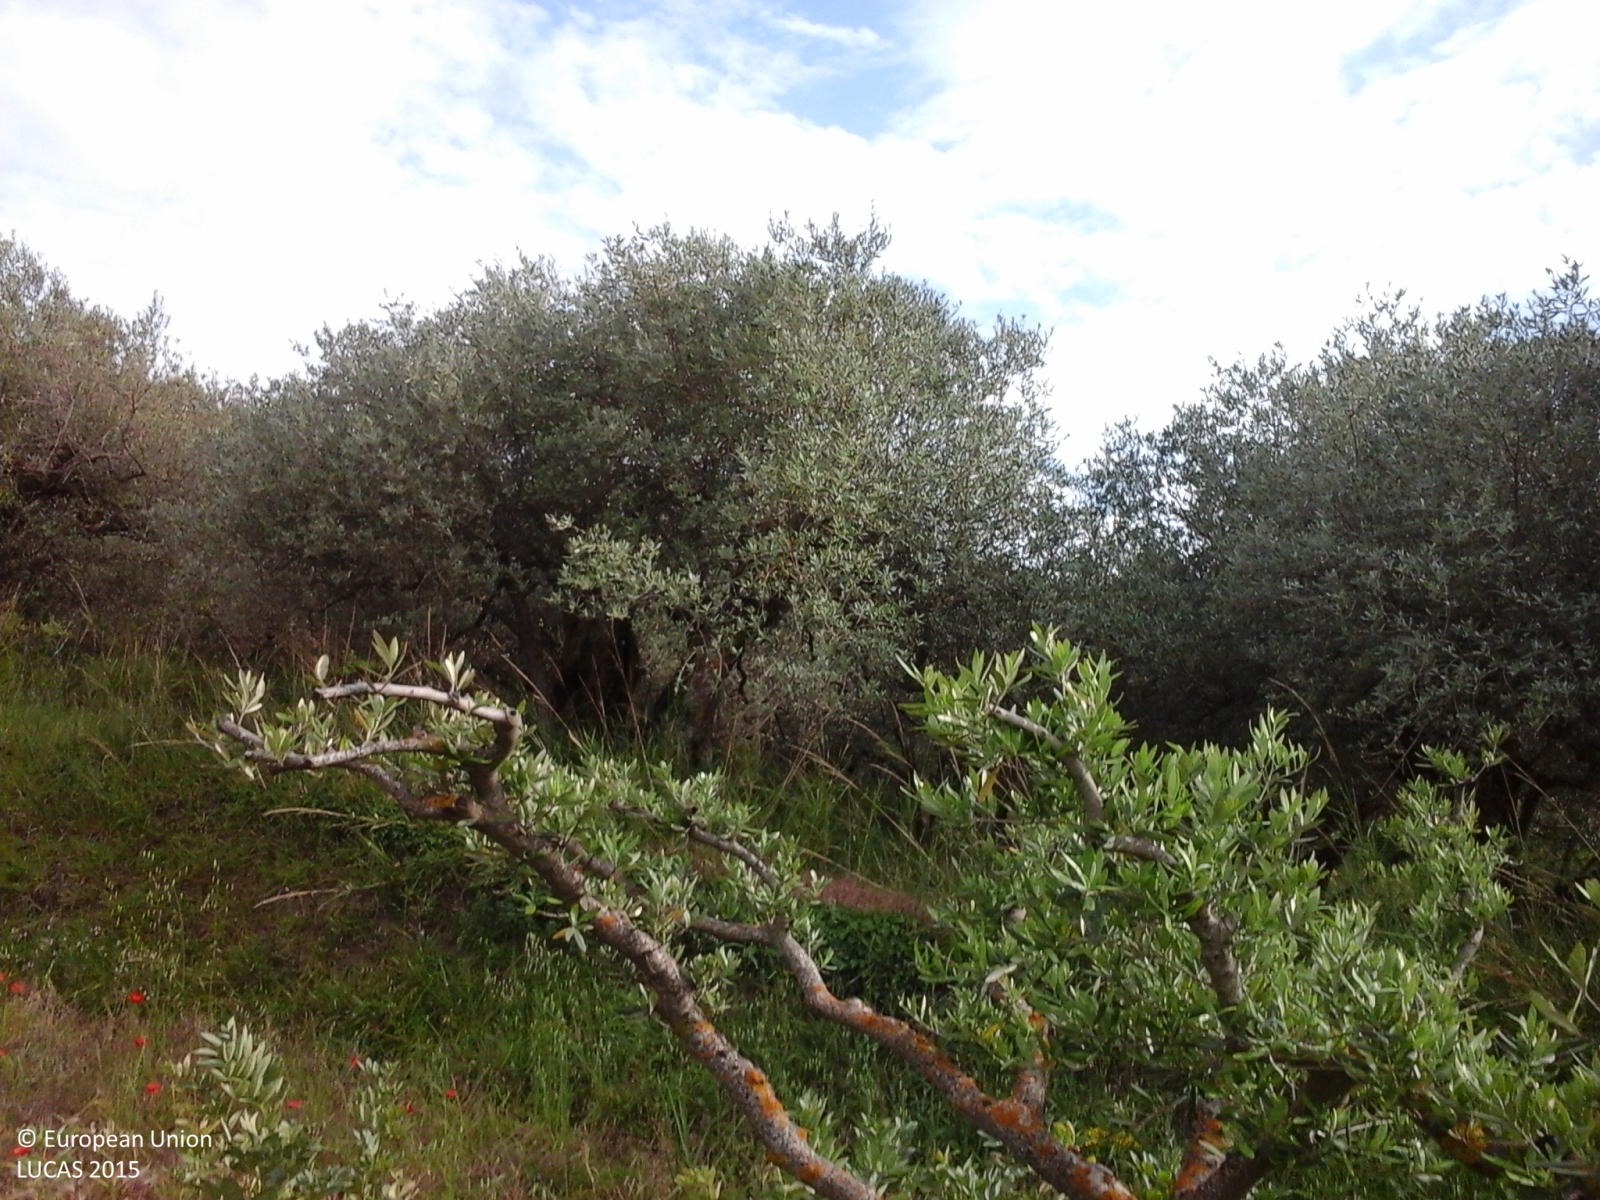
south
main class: Cropland
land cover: Olive groves
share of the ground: 50 - 75 %
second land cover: Other fresh vegetables
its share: > 75 %
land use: Agriculture (excluding fallow land and kitchen gardens)
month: June
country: IT
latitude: 37.6236
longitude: 13.6326
